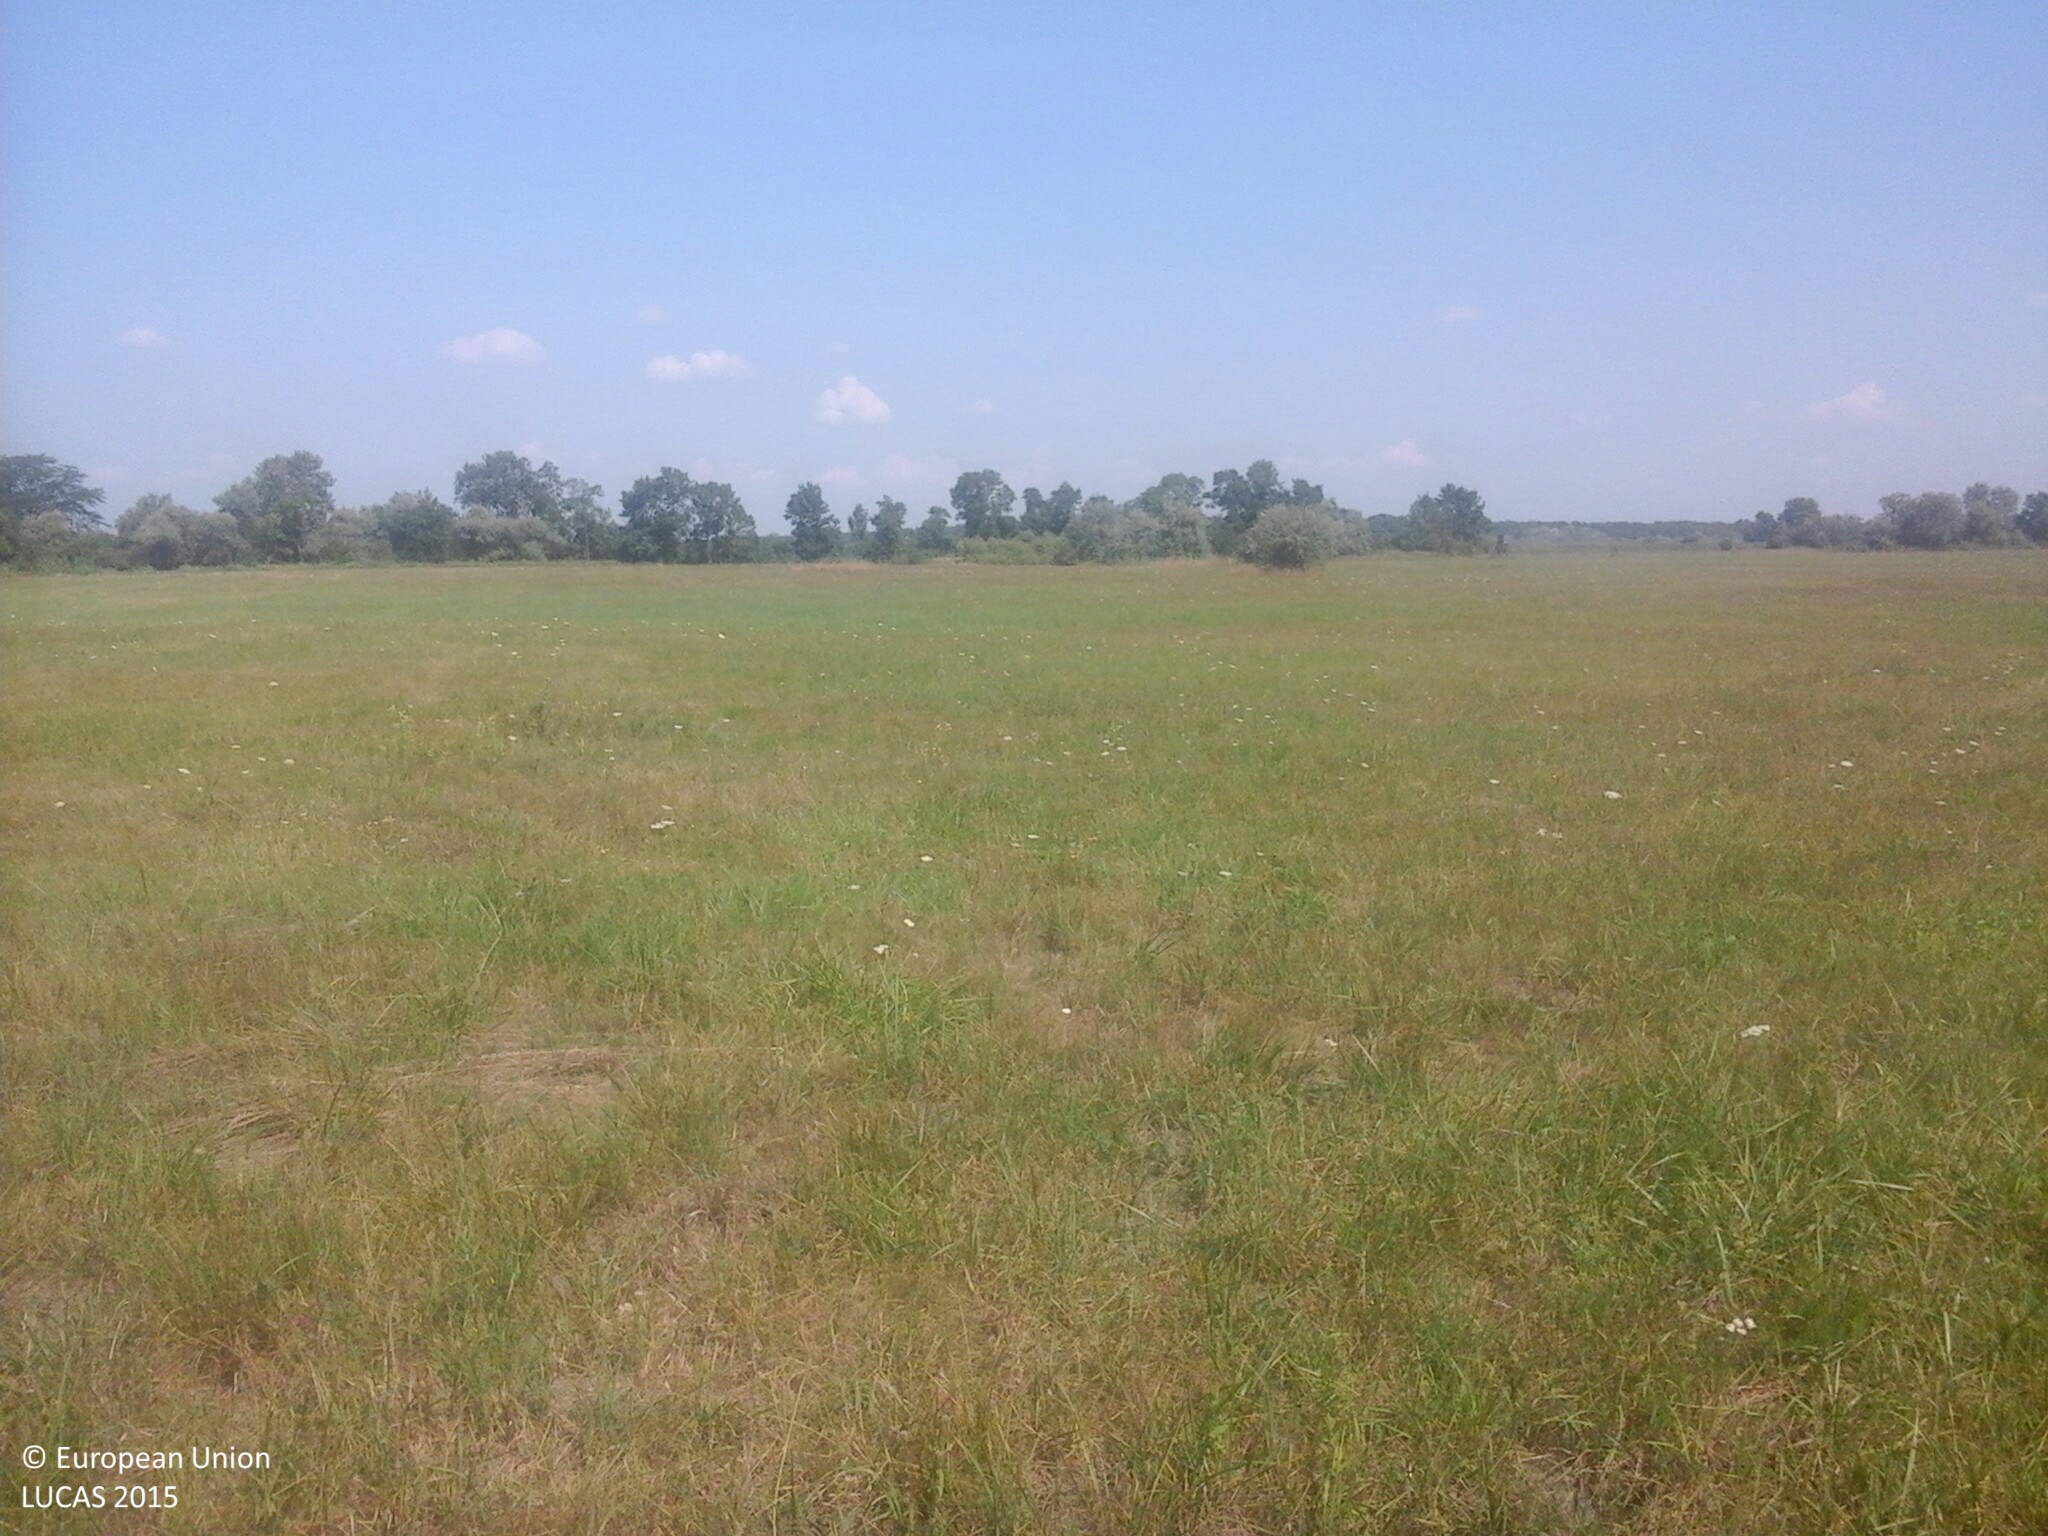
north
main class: Grassland
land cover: Grassland without tree/shrub cover
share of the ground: > 75 %
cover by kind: herbaceous plants 100 %
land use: Agriculture (excluding fallow land and kitchen gardens)
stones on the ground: < 10 %
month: August
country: HU
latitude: 46.9527
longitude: 18.5134
